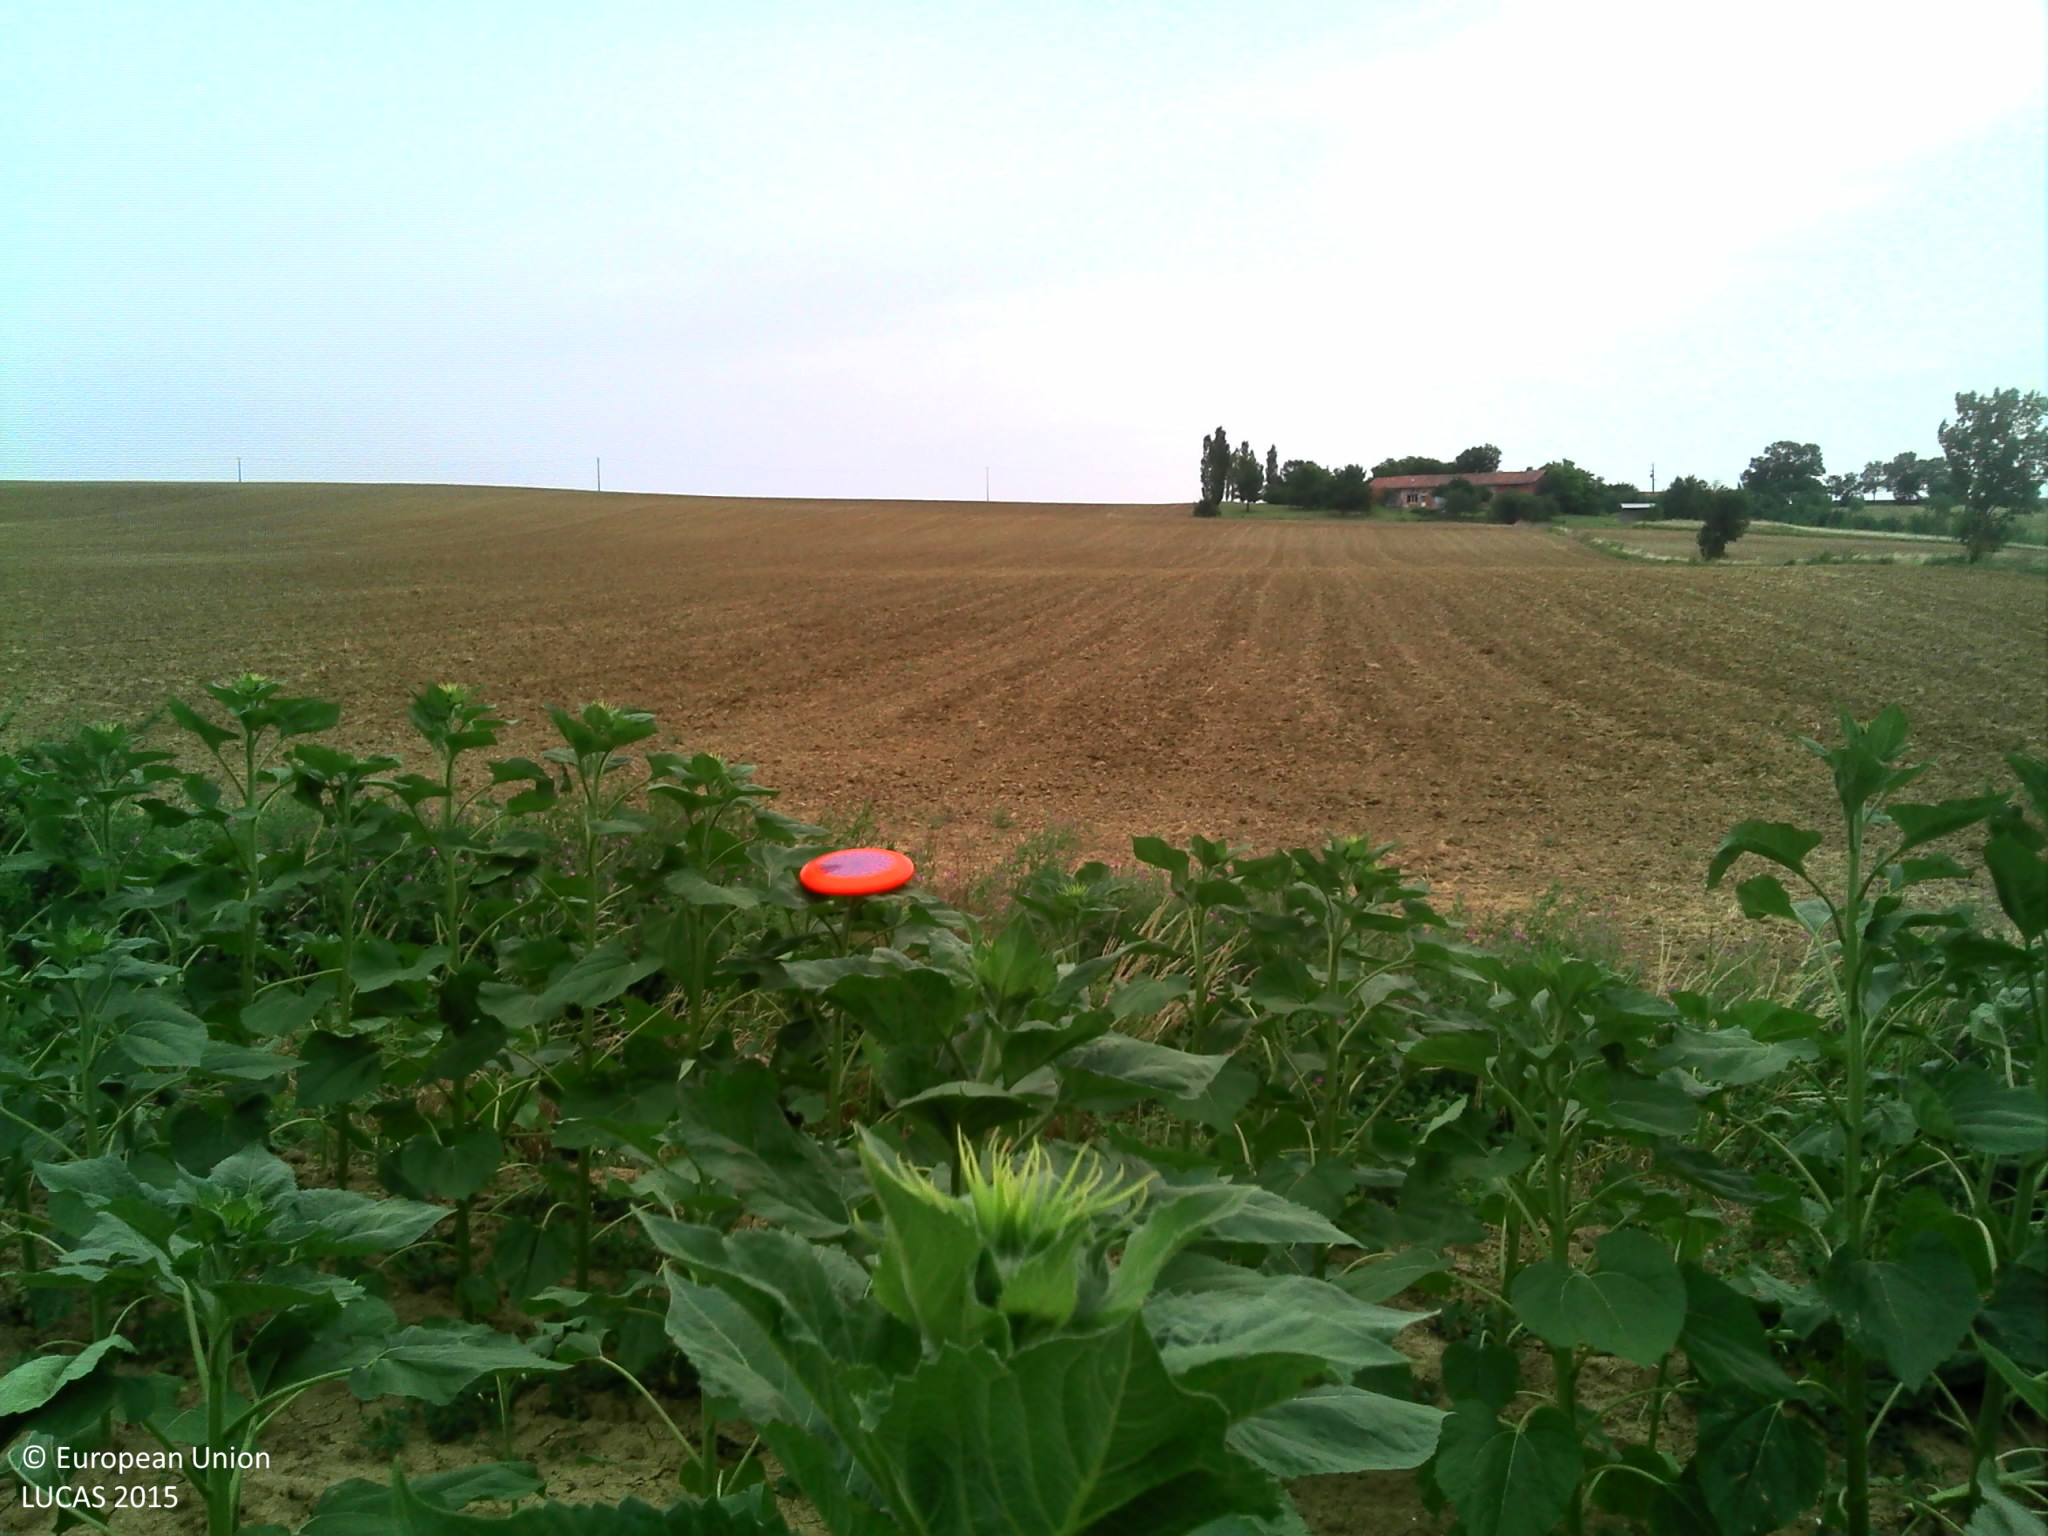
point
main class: Cropland
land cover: Sunflower
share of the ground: > 75 %
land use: Agriculture (excluding fallow land and kitchen gardens)
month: July
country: FR
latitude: 43.4785
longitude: 1.7584
